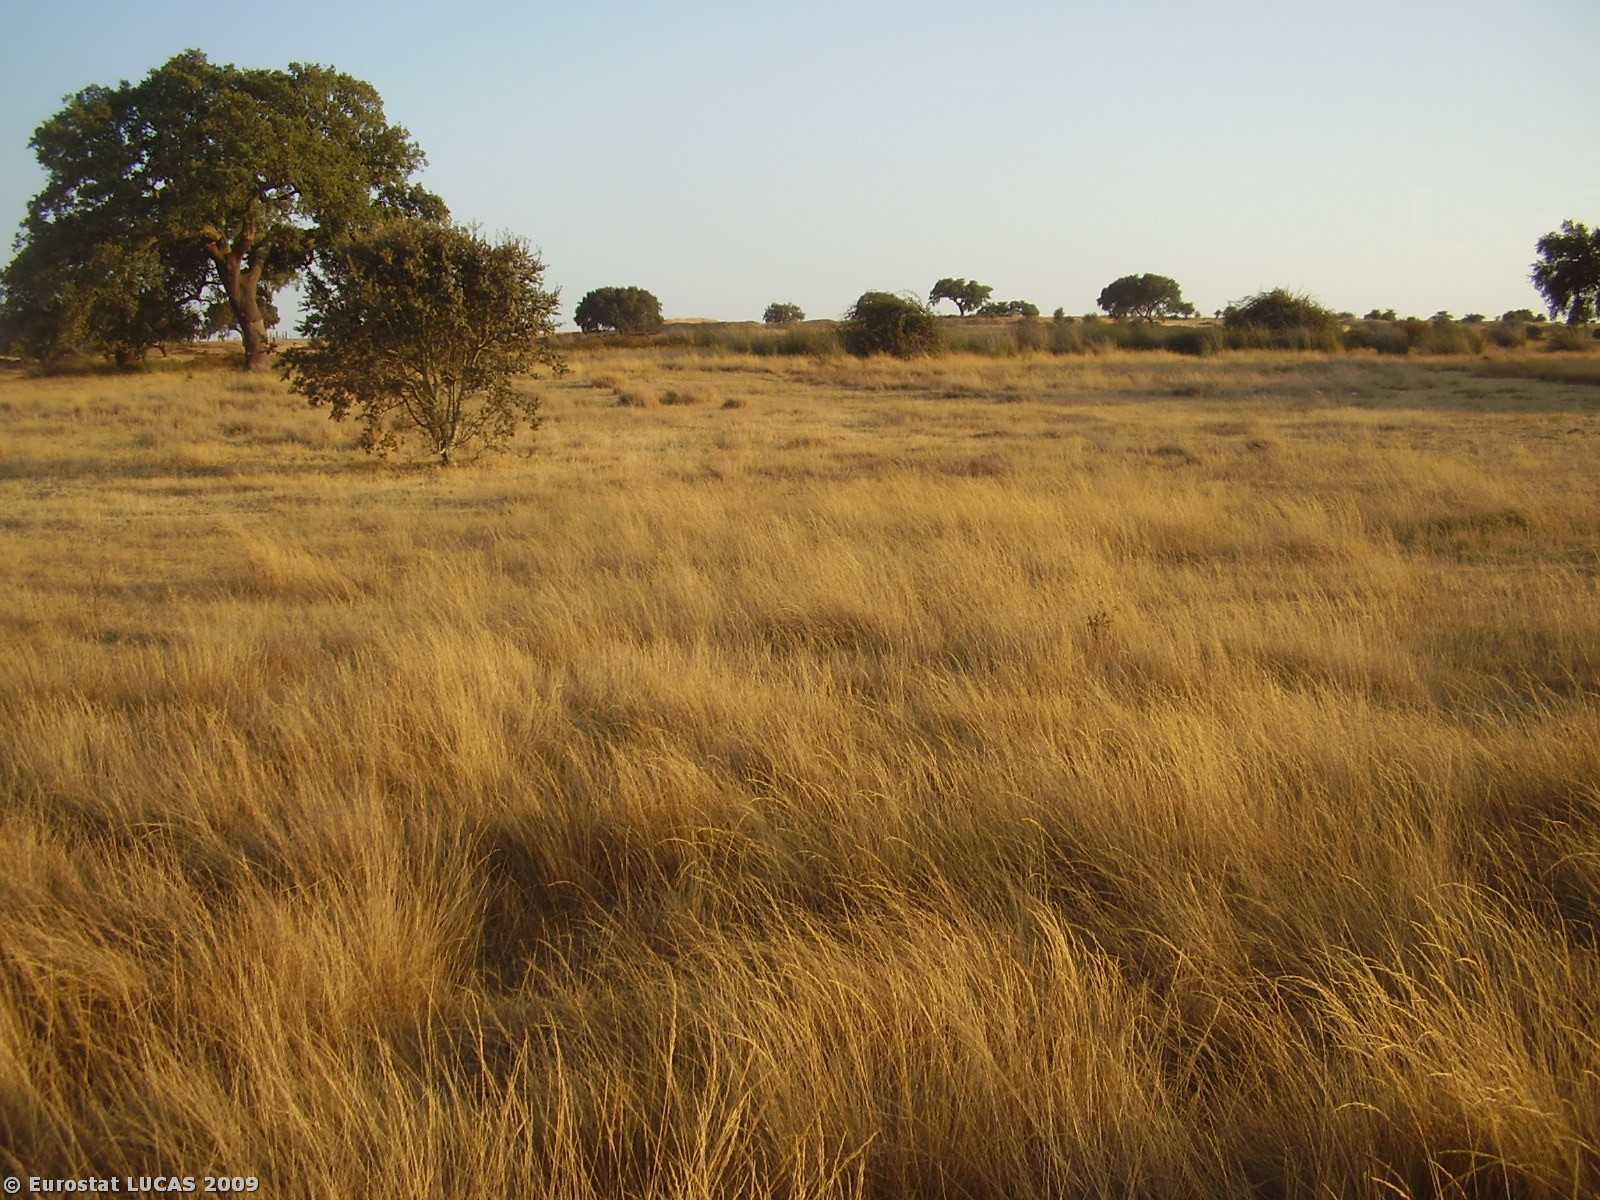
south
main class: Grassland
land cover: Grassland without tree/shrub cover
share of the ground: > 75 %
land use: Fallow land
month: August
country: PT
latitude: 37.9115
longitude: -8.4316
